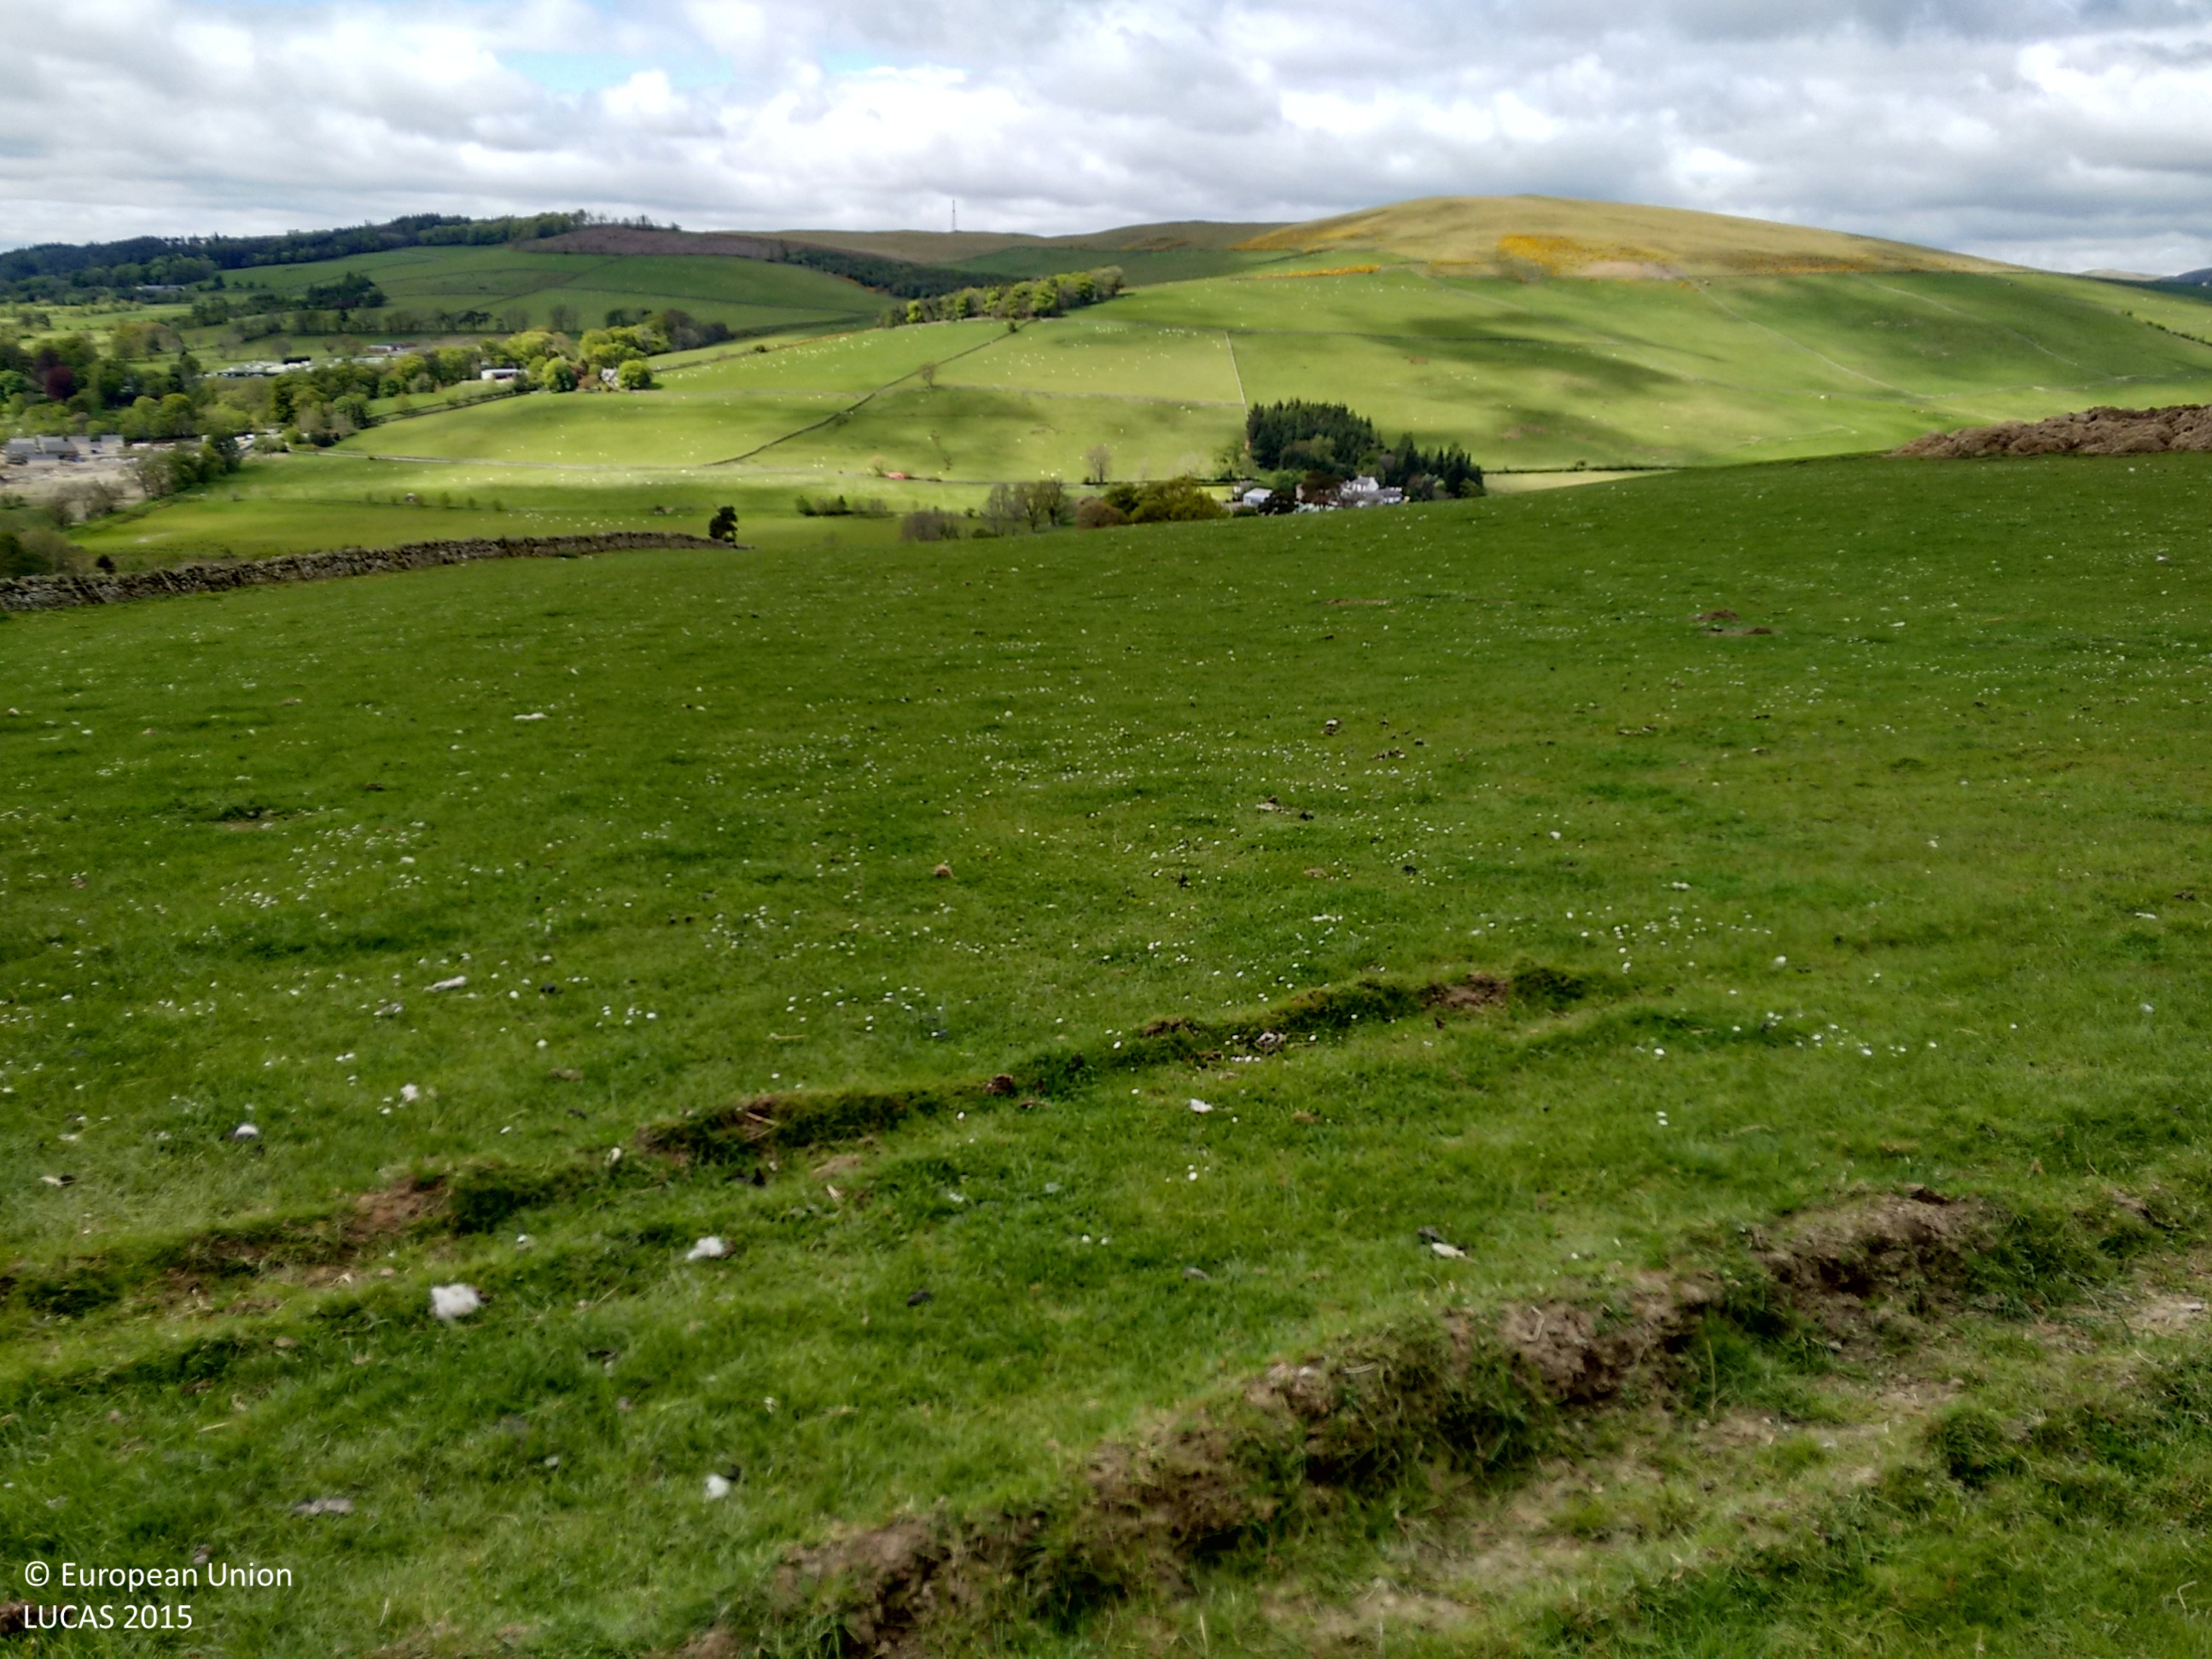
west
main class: Grassland
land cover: Grassland without tree/shrub cover
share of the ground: > 75 %
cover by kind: herbaceous plants 95 %, consolidated bare surface 5 %
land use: Agriculture (excluding fallow land and kitchen gardens)
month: May
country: GB
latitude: 55.6673
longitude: -3.1886
